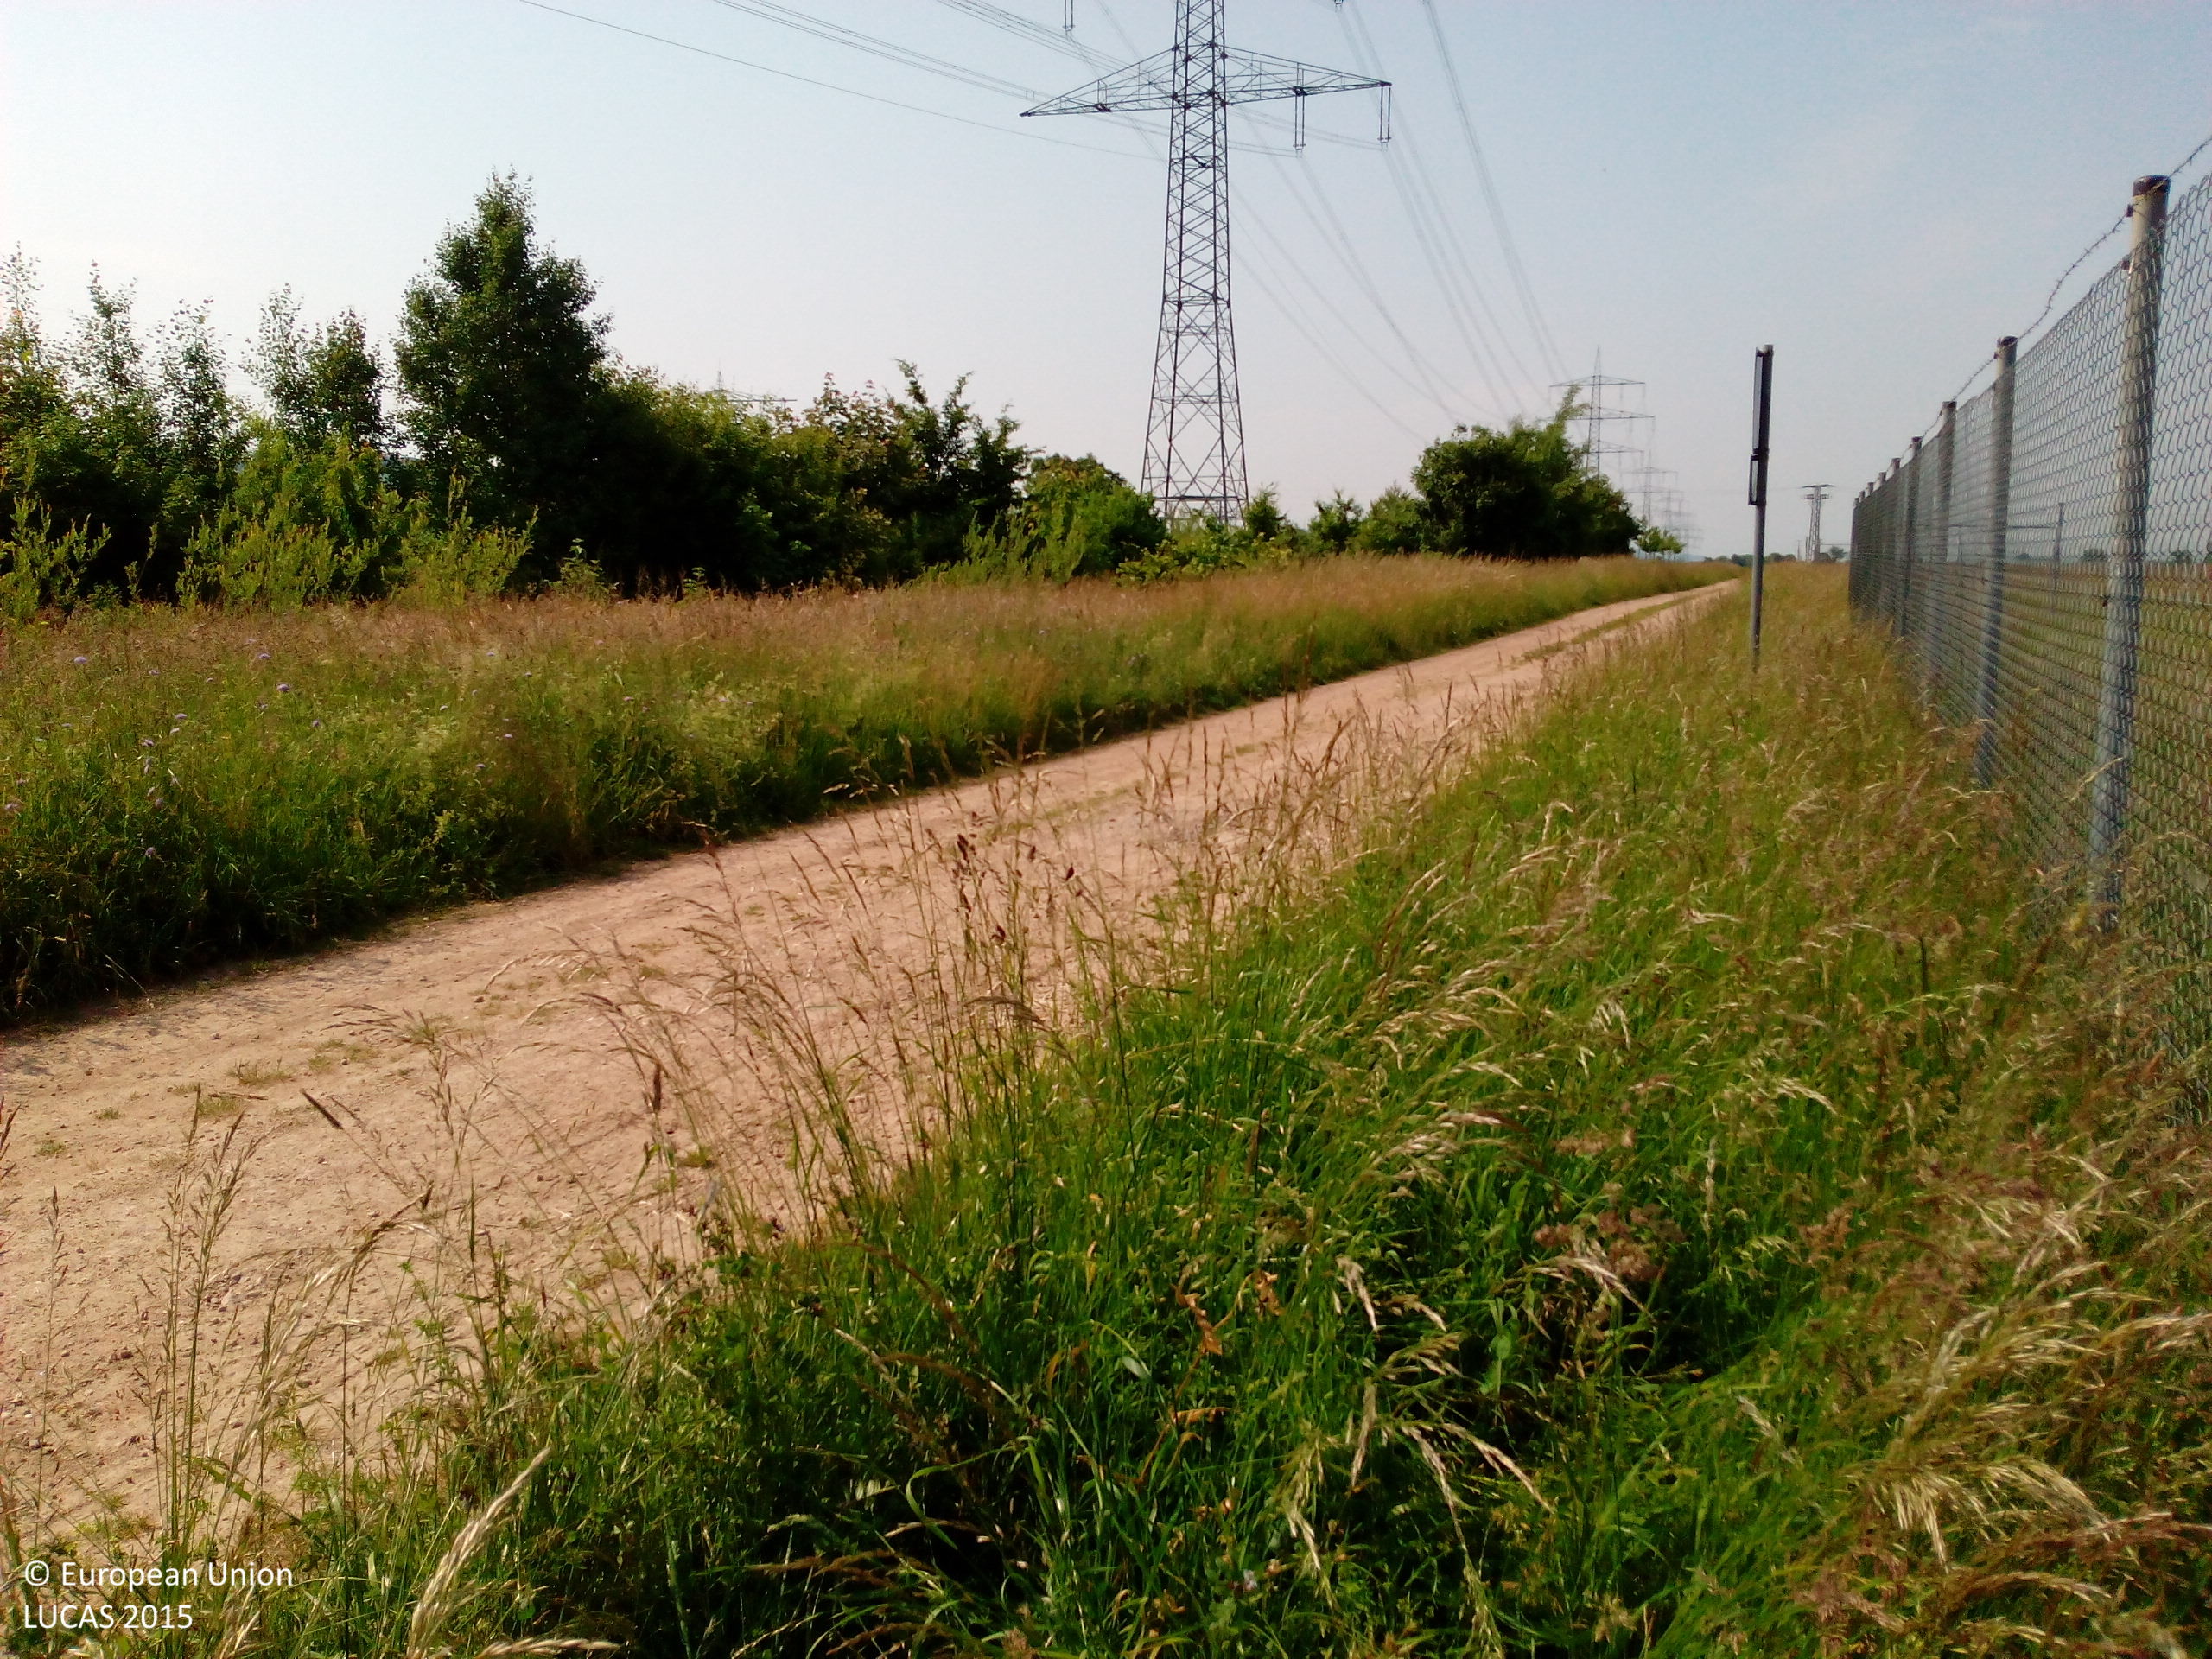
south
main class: Grassland
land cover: Grassland without tree/shrub cover
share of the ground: > 75 %
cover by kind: herbaceous plants 100 %
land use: Water supply and treatment
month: May
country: DE
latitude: 47.8010
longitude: 7.5848
